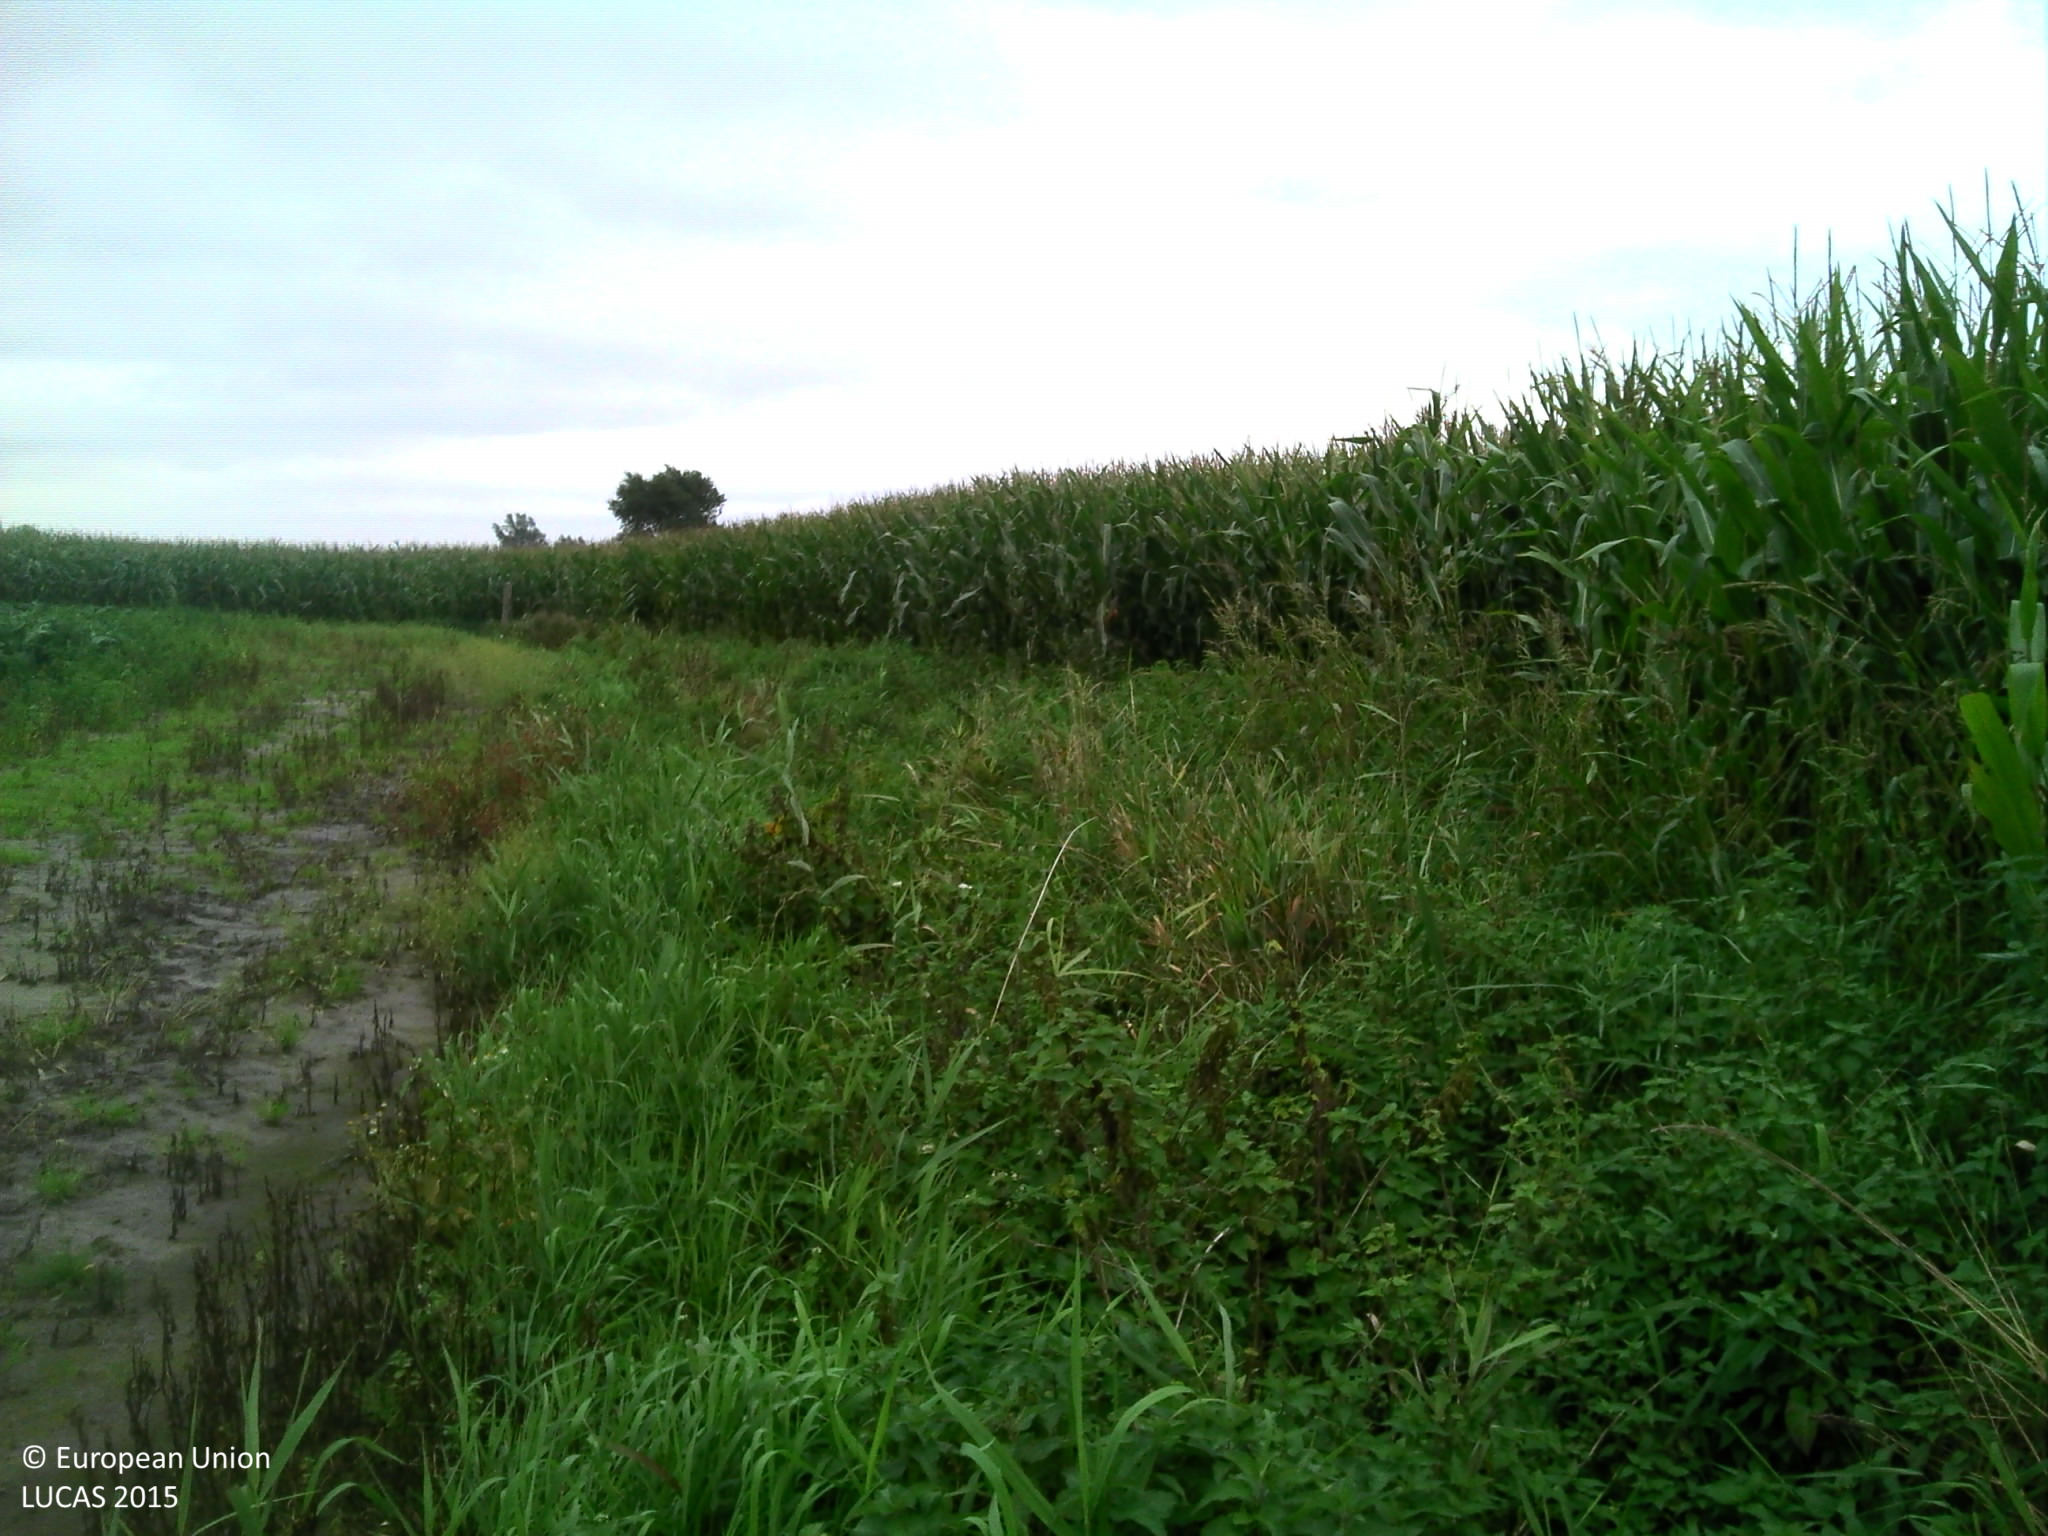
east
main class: Cropland
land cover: Maize
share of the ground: > 75 %
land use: Agriculture (excluding fallow land and kitchen gardens)
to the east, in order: Maize; Grass margins; Fences; Grassland without tree/shrub cover; Other bare soil
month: September
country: BE
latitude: 51.0620
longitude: 2.8691
